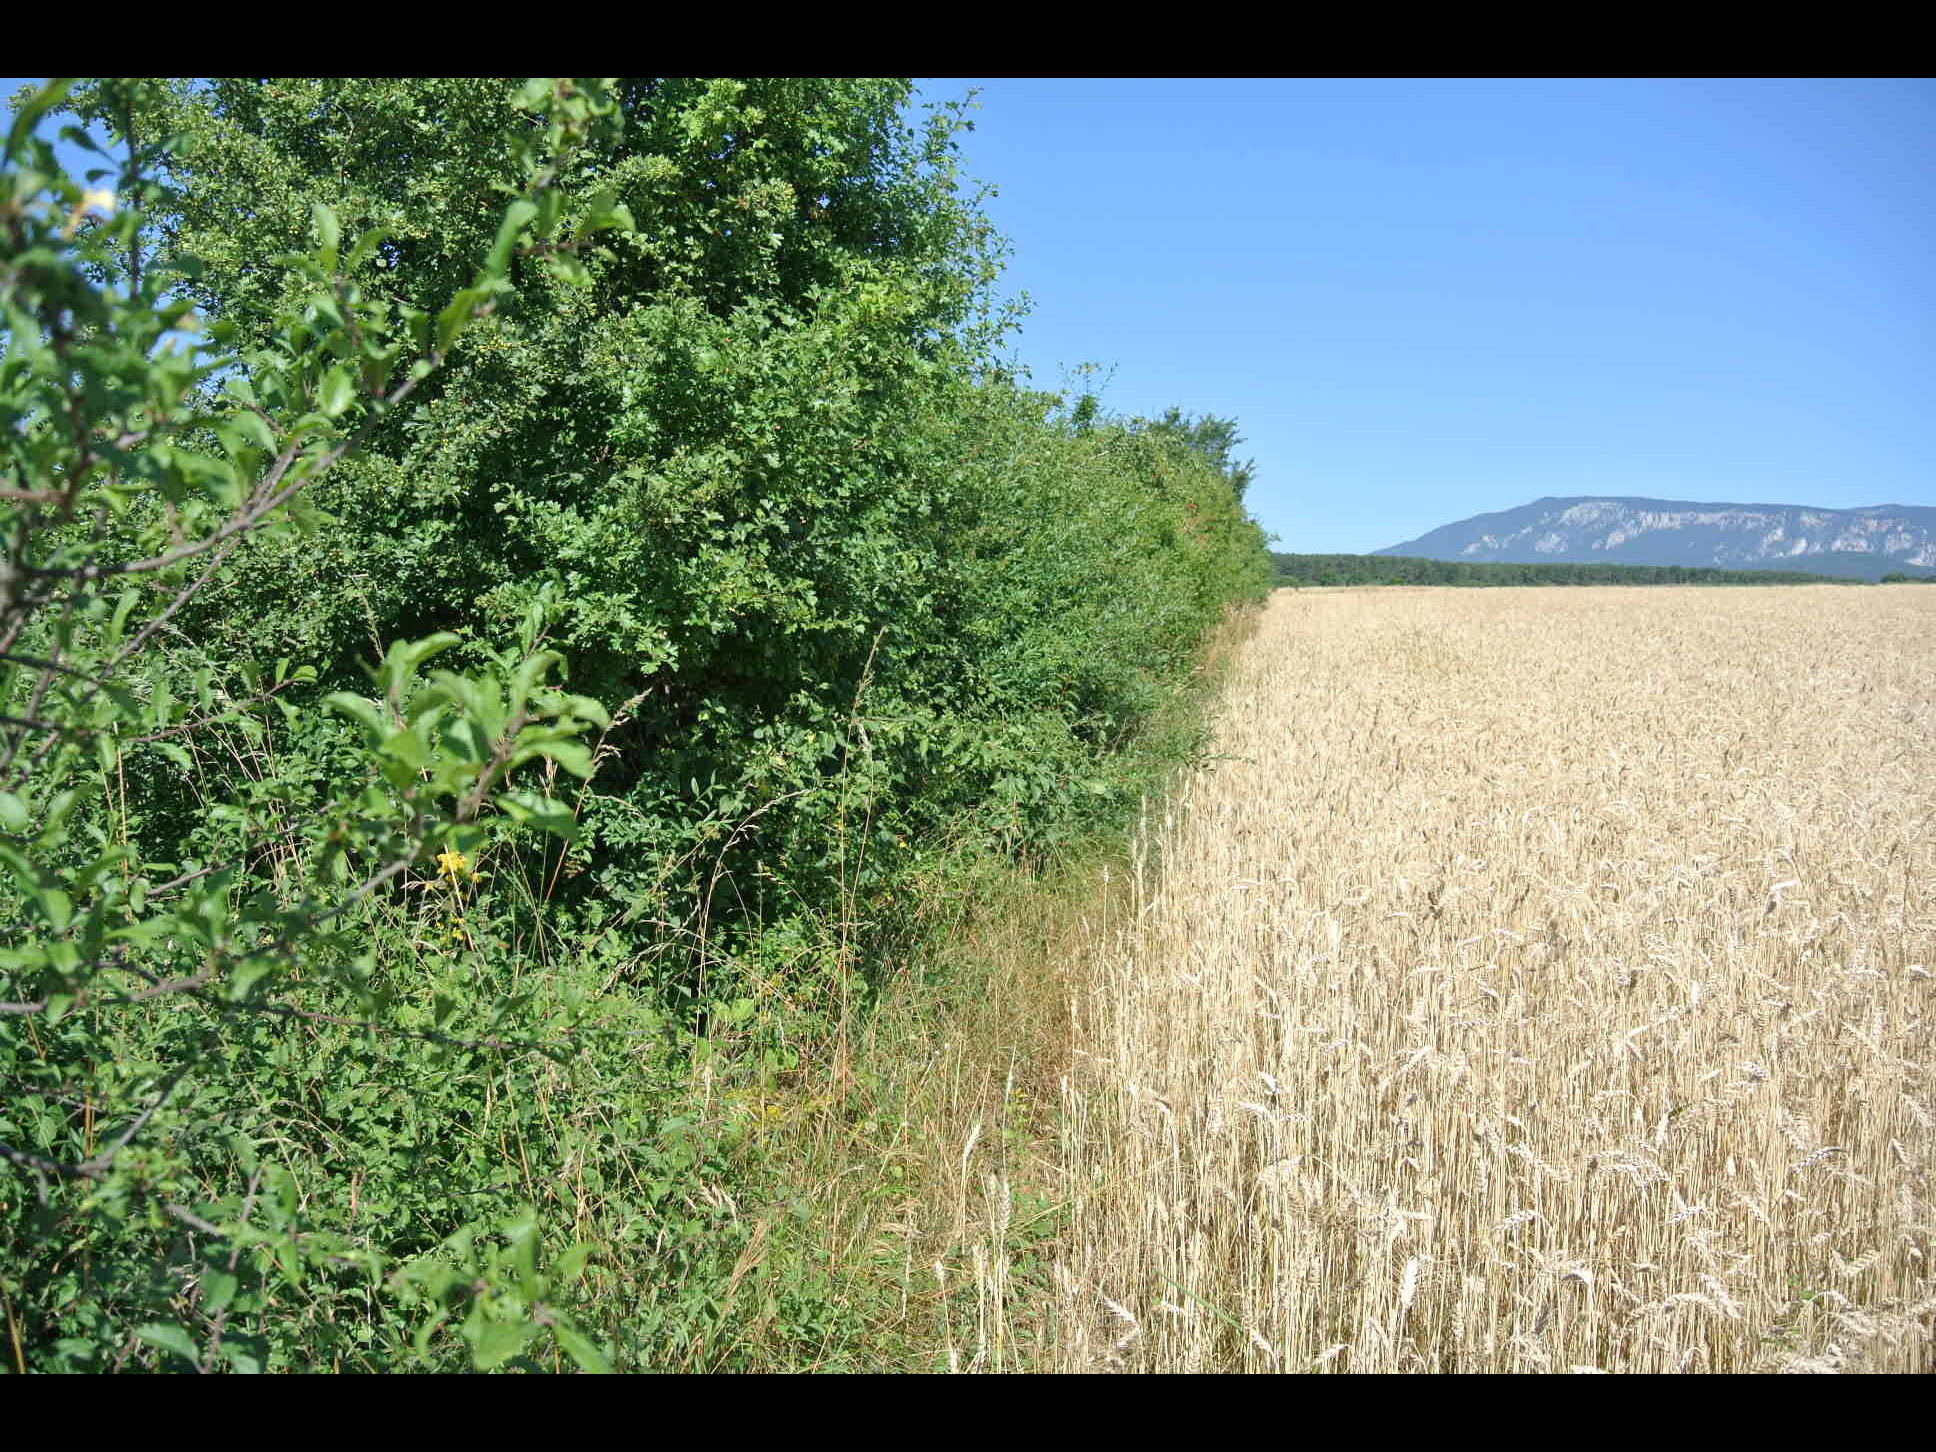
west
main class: Cropland
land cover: Durum wheat
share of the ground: > 75 %
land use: Agriculture (excluding fallow land and kitchen gardens)
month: July
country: AT
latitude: 47.7658
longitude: 16.1006
